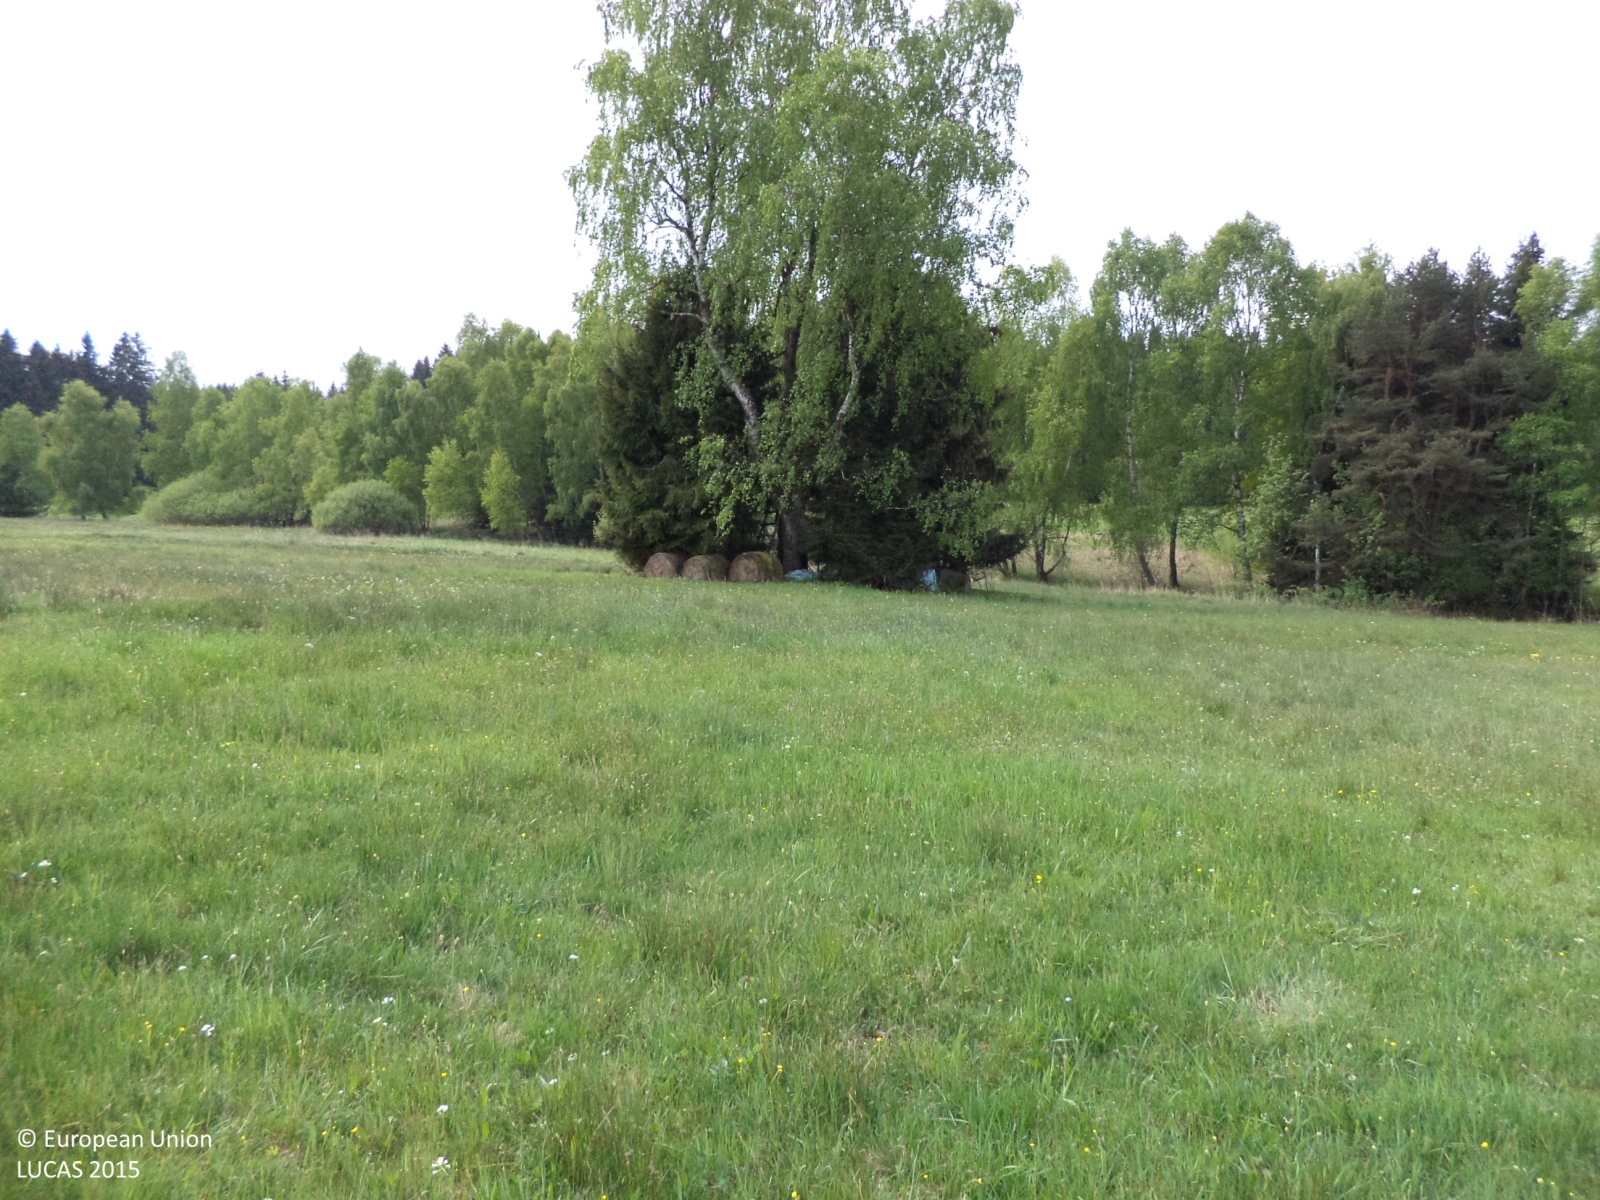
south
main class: Grassland
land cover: Grassland without tree/shrub cover
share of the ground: > 75 %
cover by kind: herbaceous plants 100 %
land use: Agriculture (excluding fallow land and kitchen gardens)
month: May
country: CZ
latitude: 49.3681
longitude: 15.0840
